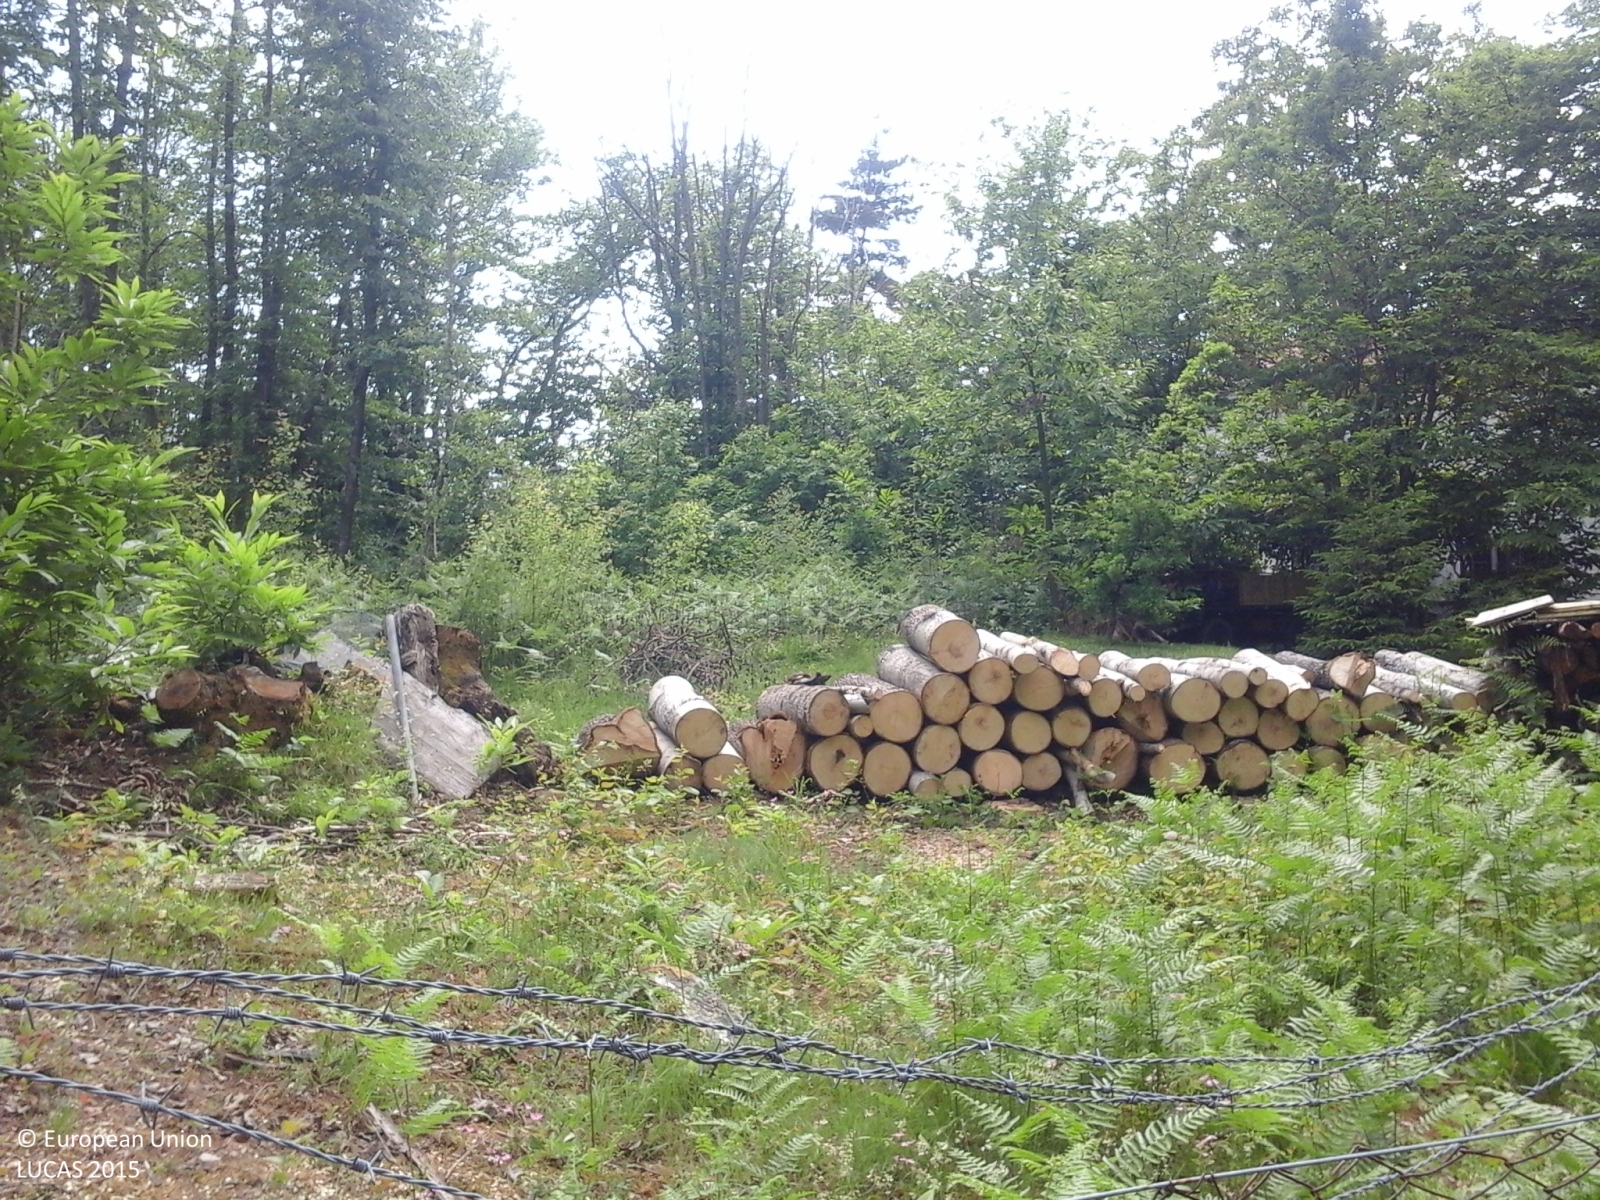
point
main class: Woodland
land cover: Broadleaved woodland
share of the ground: 50 - 75 %
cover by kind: broadleaved forest trees 100 %
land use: Forestry
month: May
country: IT
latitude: 44.4942
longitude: 9.6361
